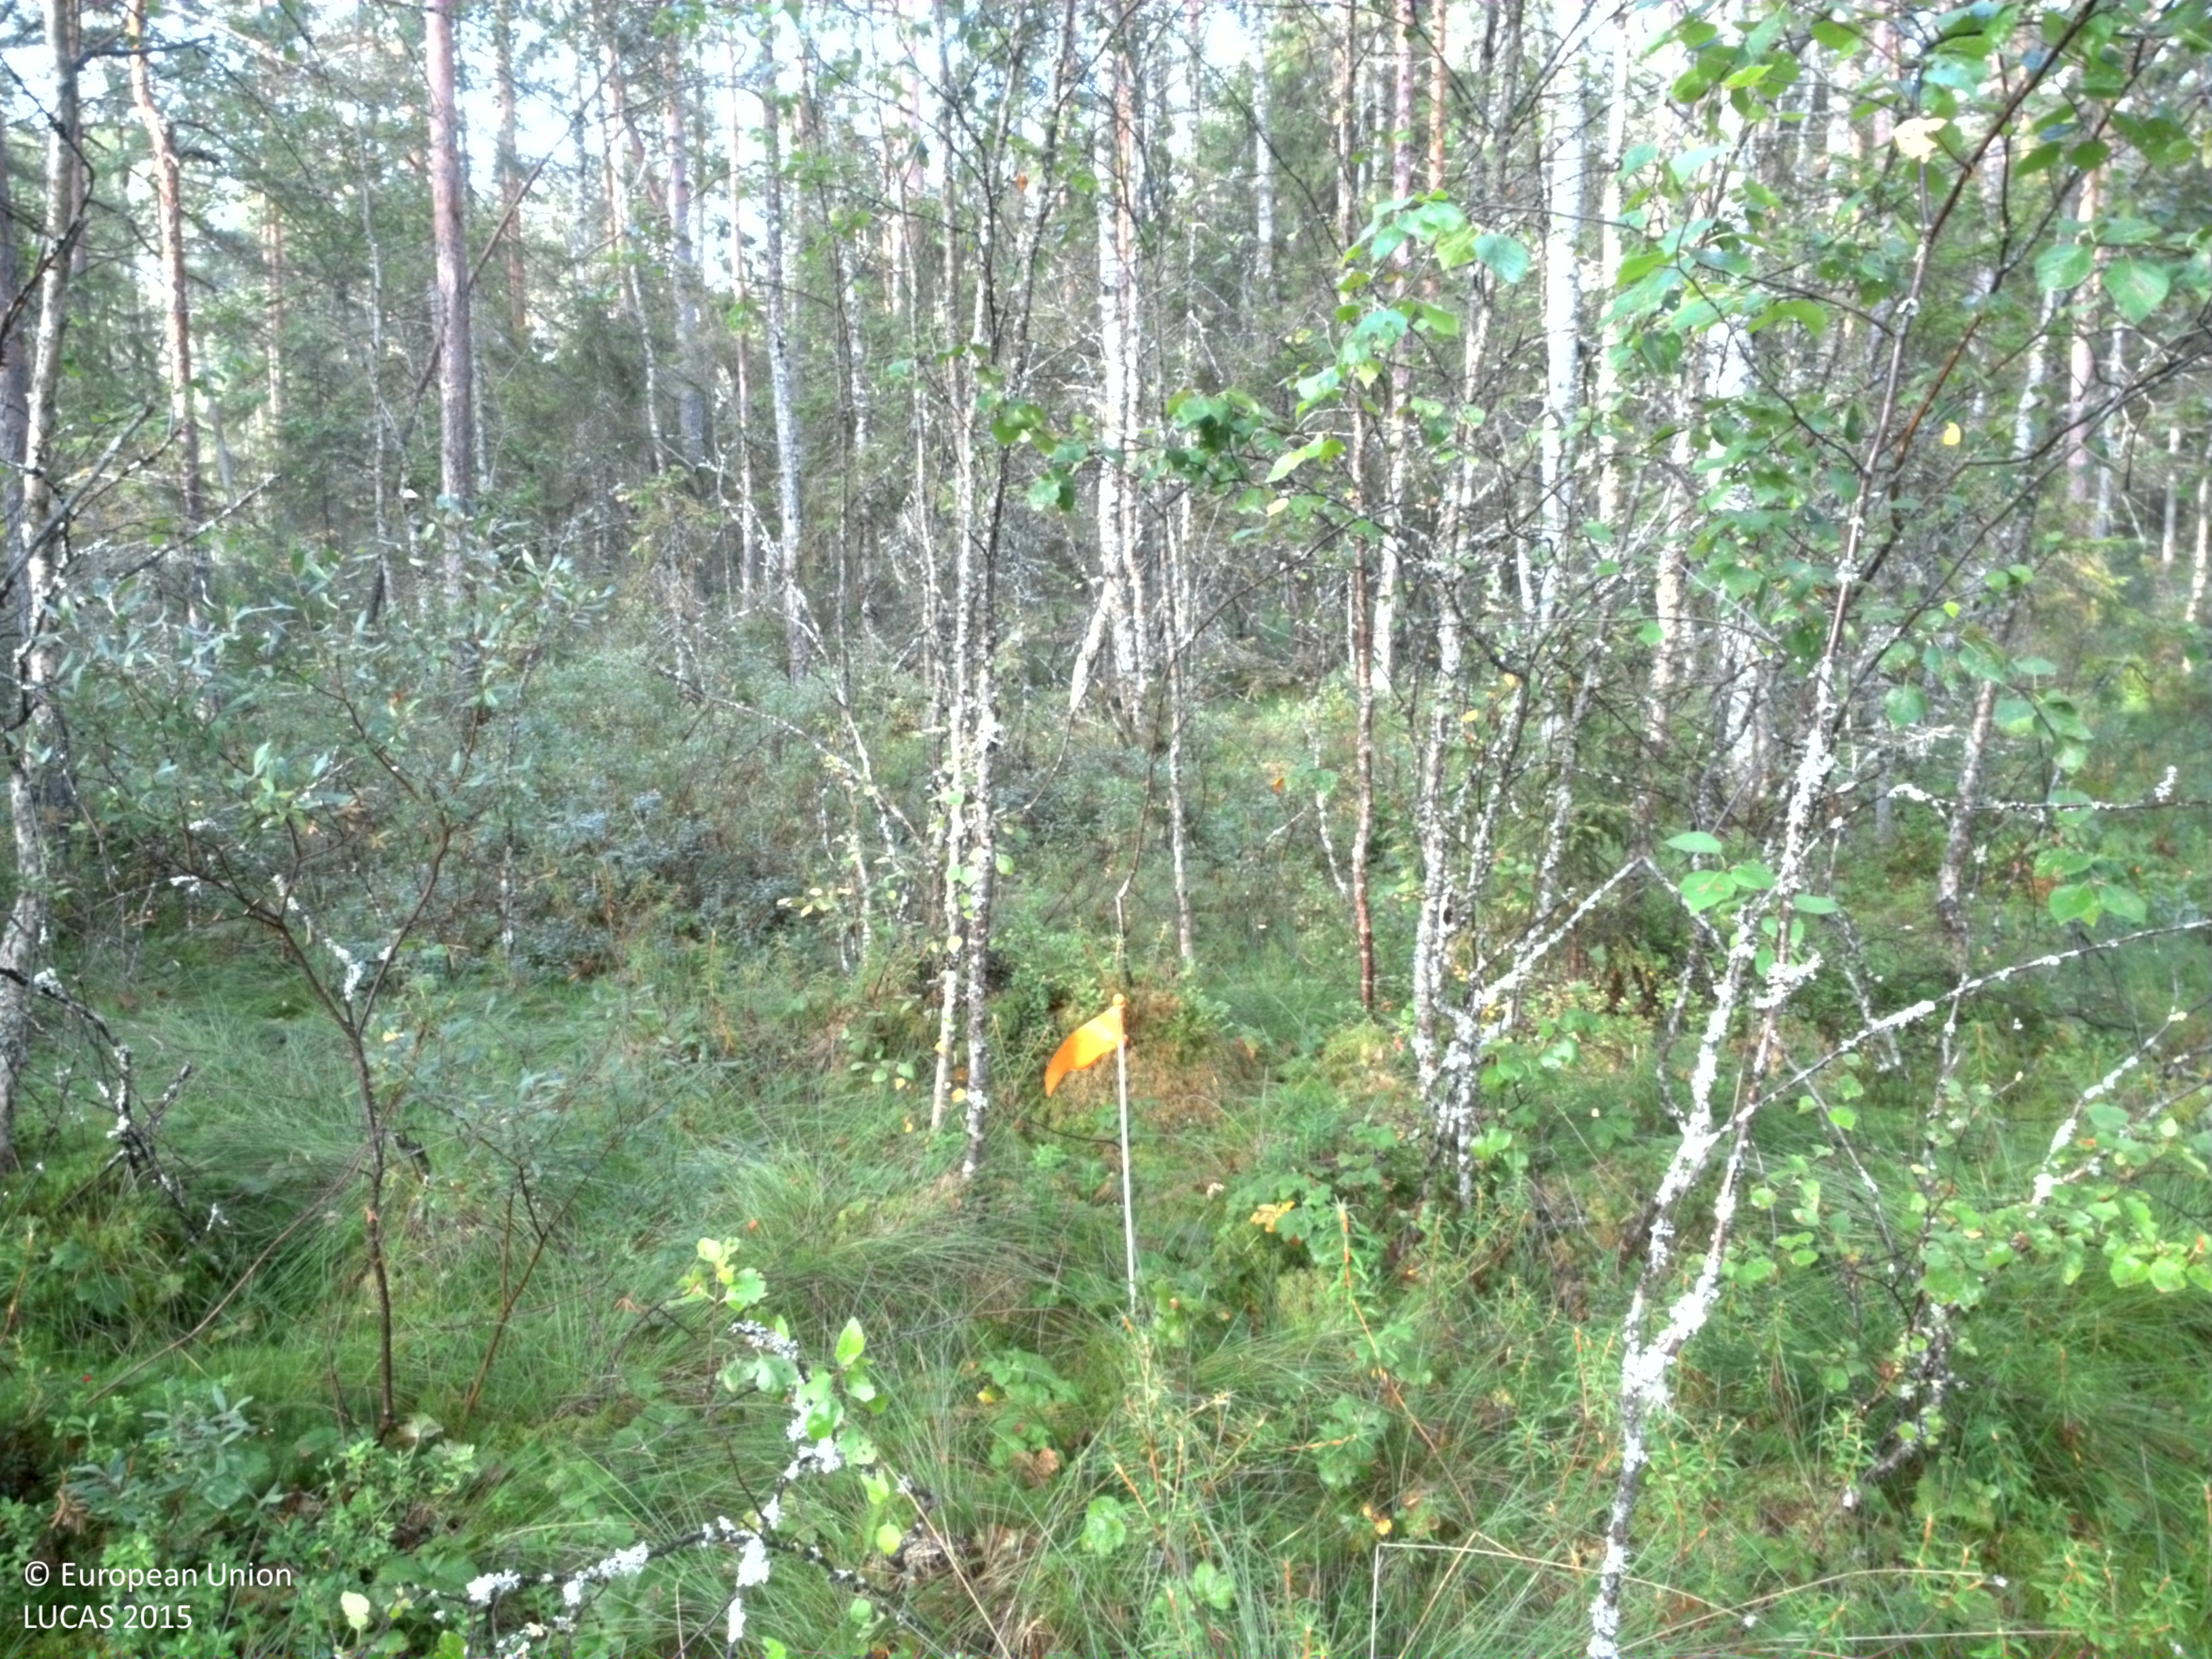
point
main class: Woodland
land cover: Pine dominated mixed woodland
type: boreal forest
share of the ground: 50 - 75 %
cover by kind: coniferous forest trees 45 %, broadleaved forest trees 20 %, shrubs 20 %, lichens and mosses 15 %
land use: Forestry
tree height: > 5 m
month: August
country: SE
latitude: 59.8165
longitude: 15.6071
